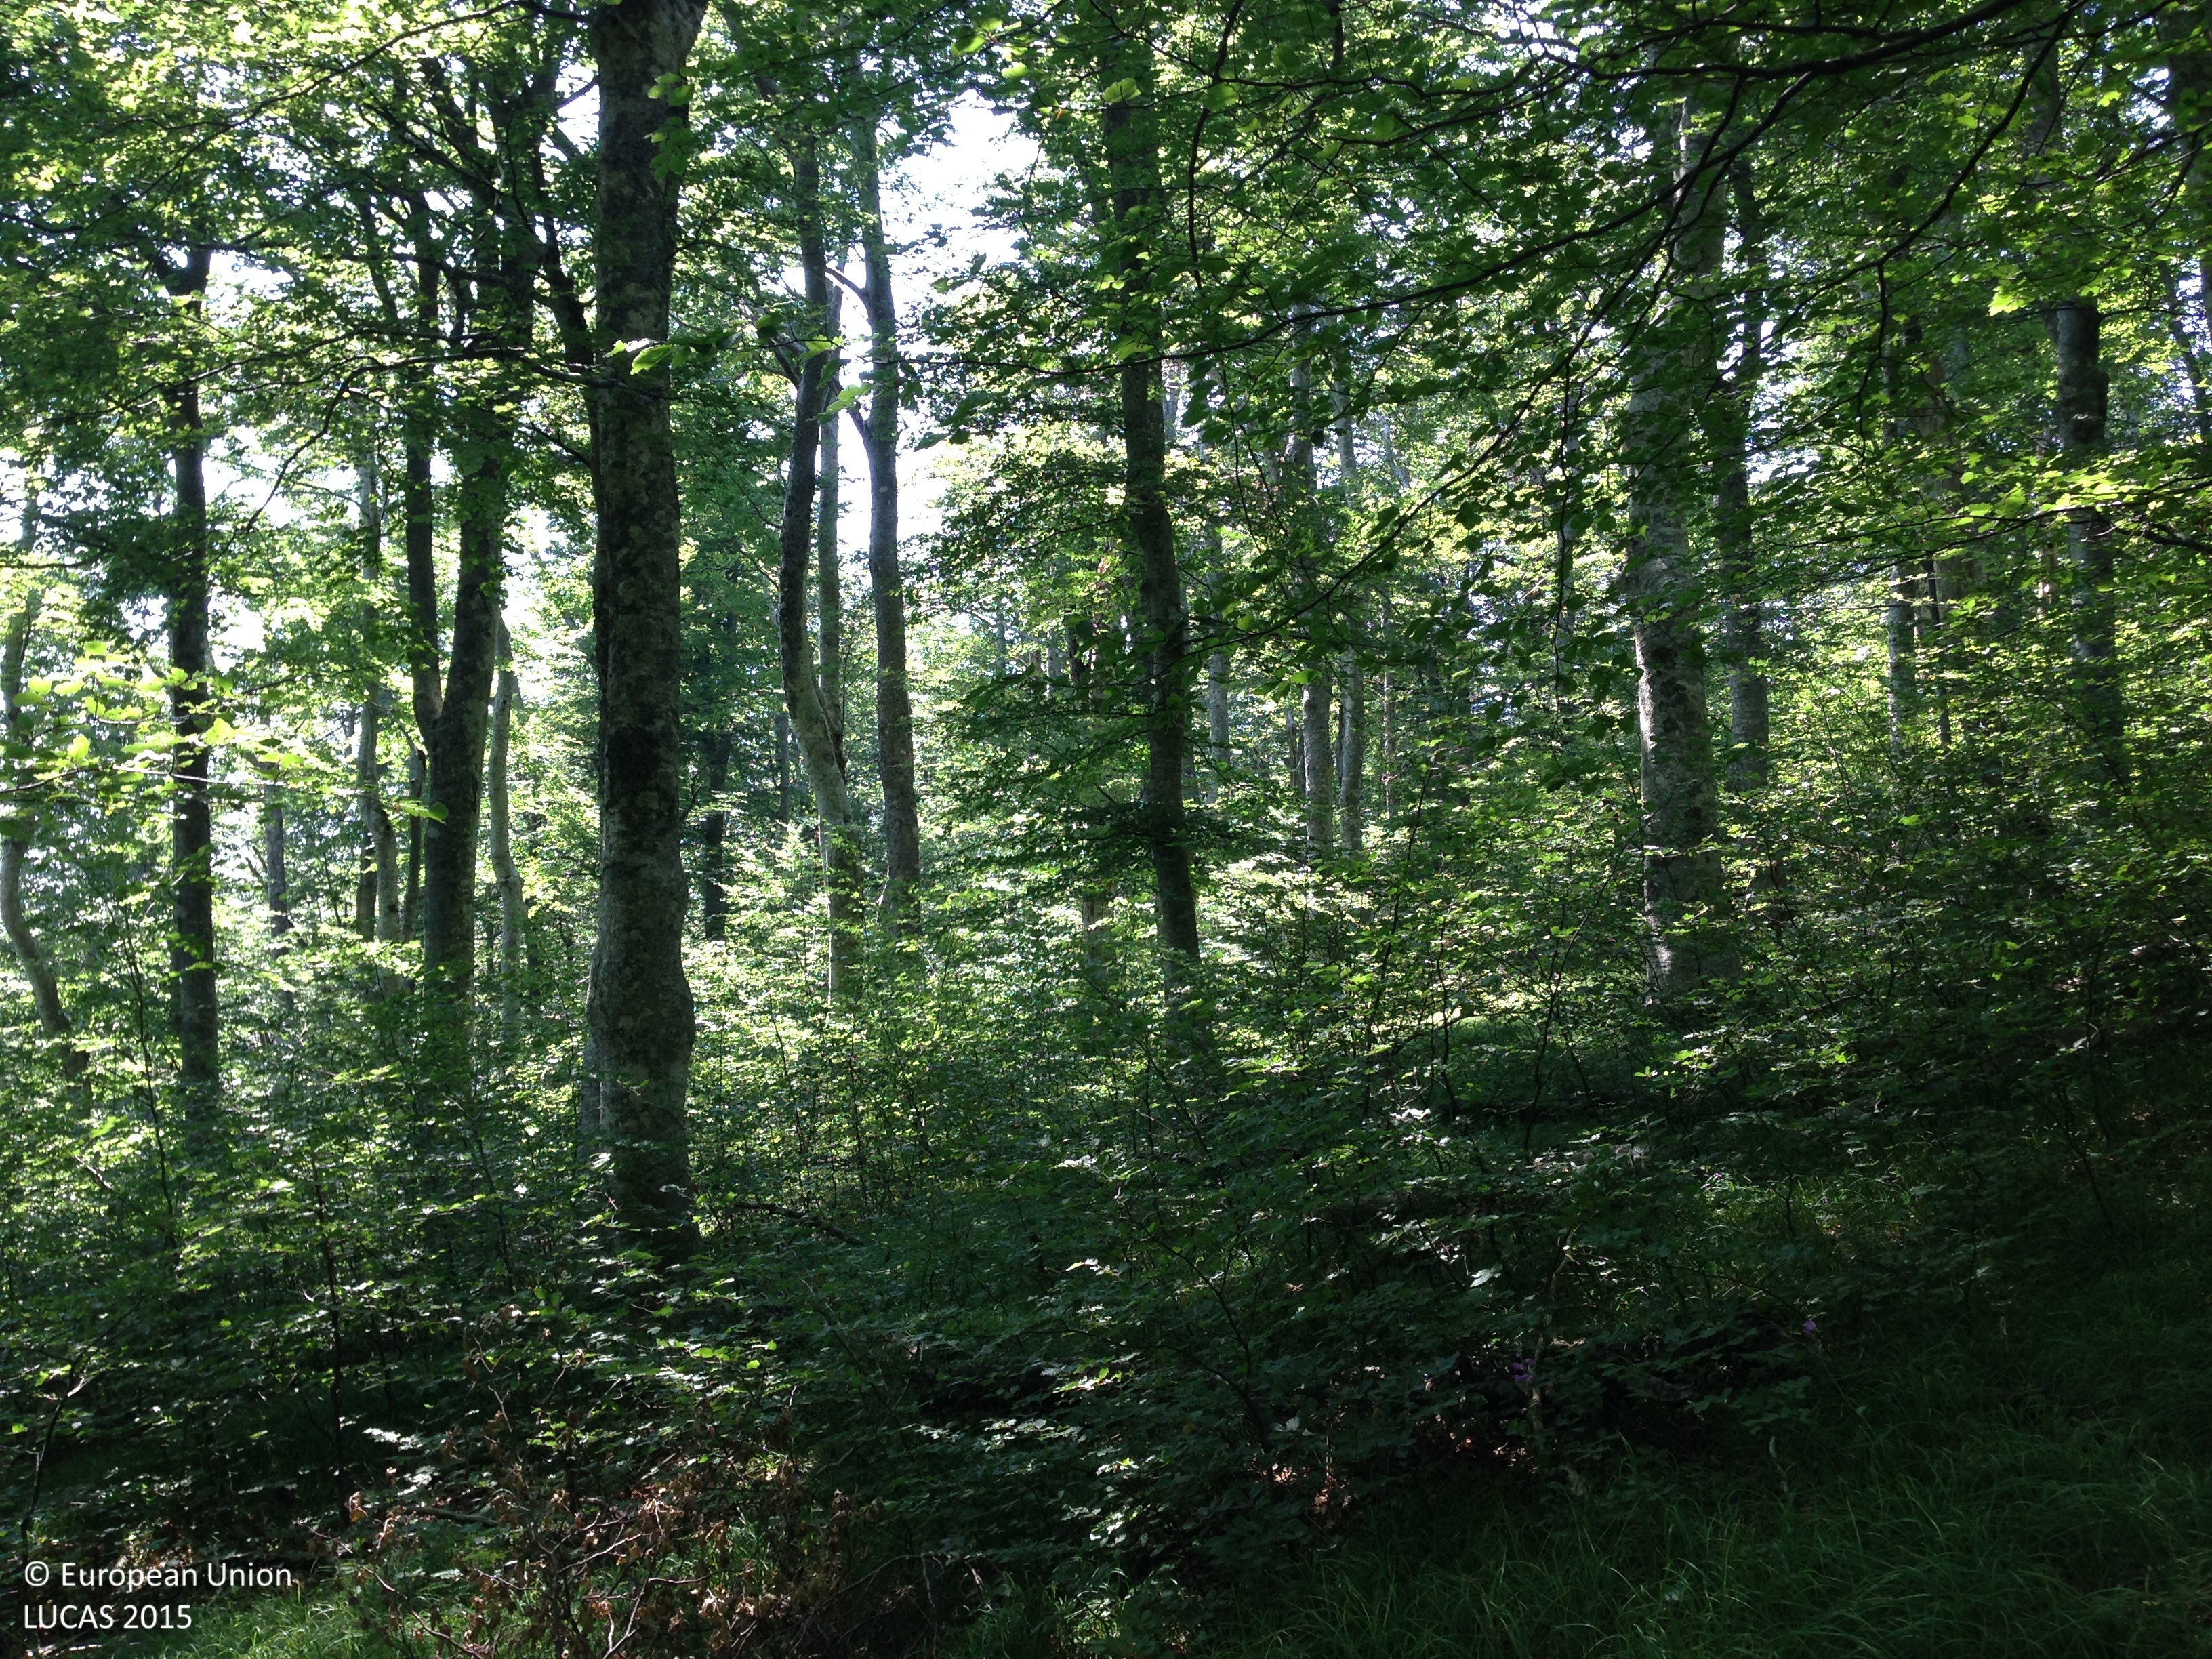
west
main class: Woodland
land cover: Broadleaved woodland
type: mountainous beech forest
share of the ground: > 75 %
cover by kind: broadleaved forest trees 75 %, herbaceous plants 15 %, shrubs 5 %, lichens and mosses 5 %
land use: Forestry
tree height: > 5 m
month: July
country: HR
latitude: 44.5291
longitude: 15.1649
